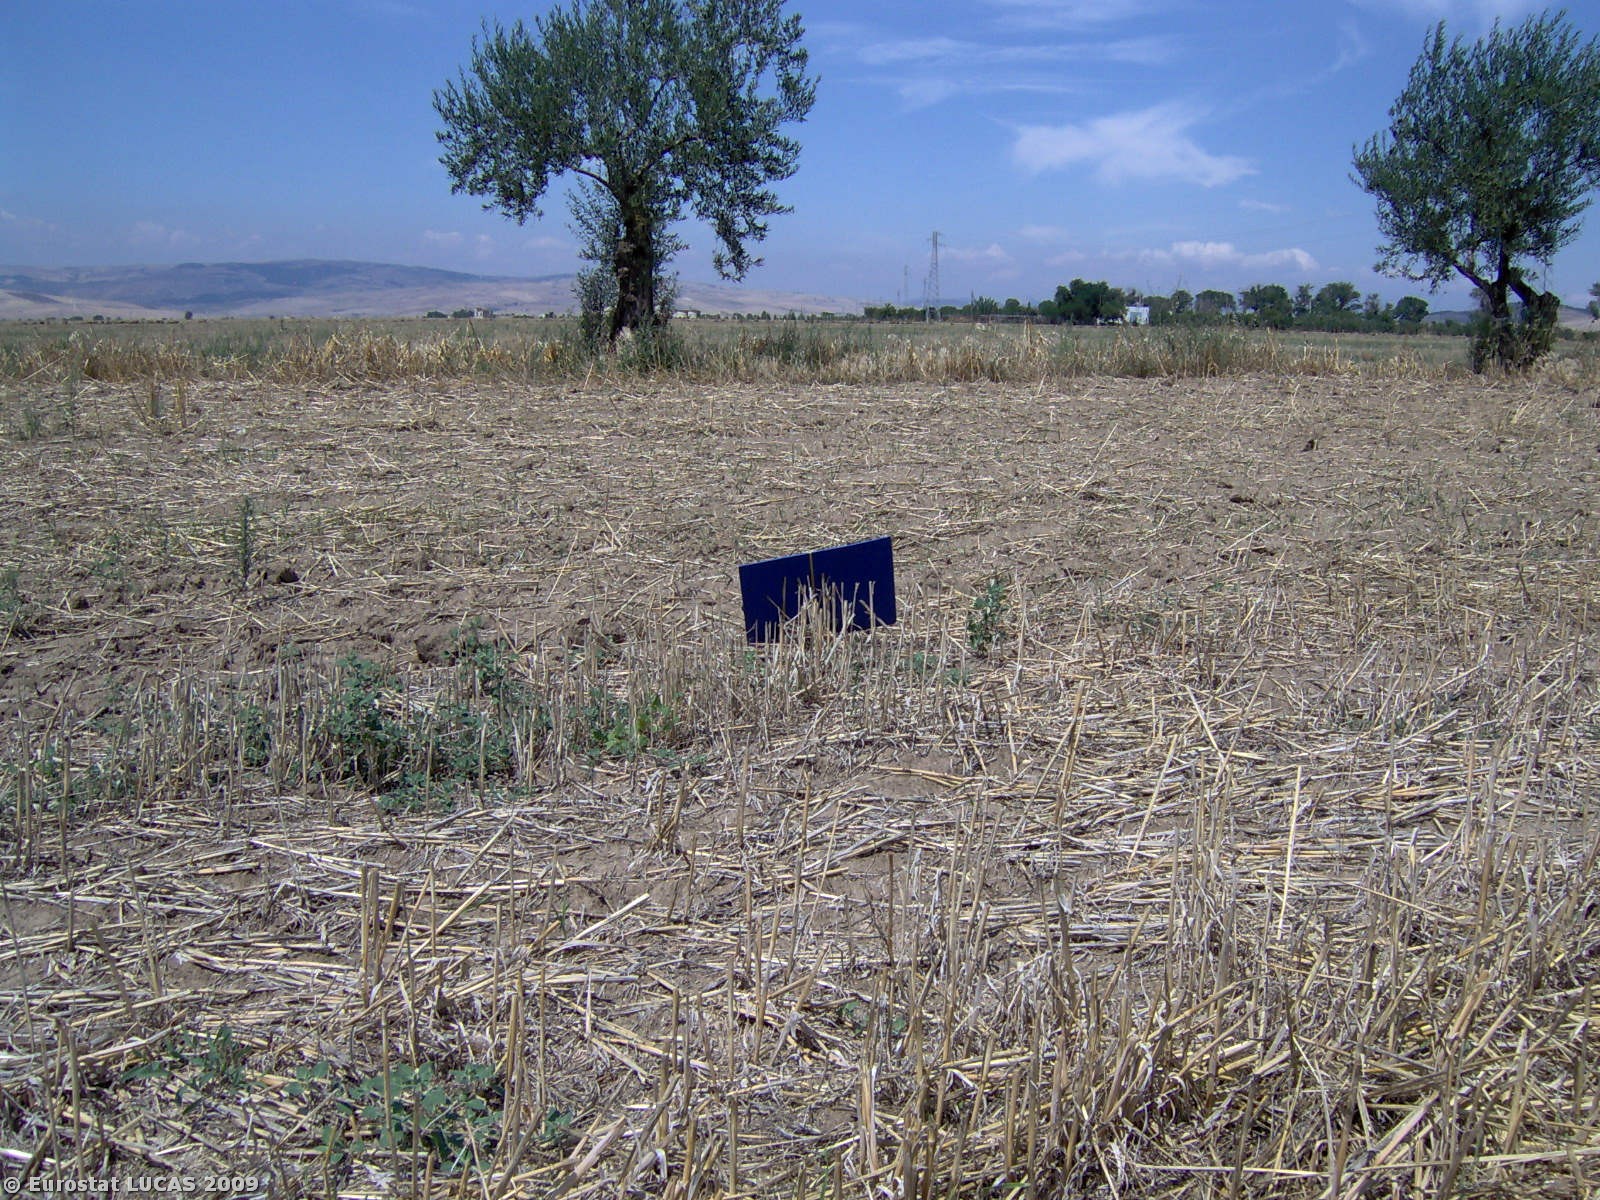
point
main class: Cropland
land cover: Durum wheat
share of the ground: < 10 %
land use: Agriculture (excluding fallow land and kitchen gardens)
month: July
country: IT
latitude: 41.1011
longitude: 15.6596
